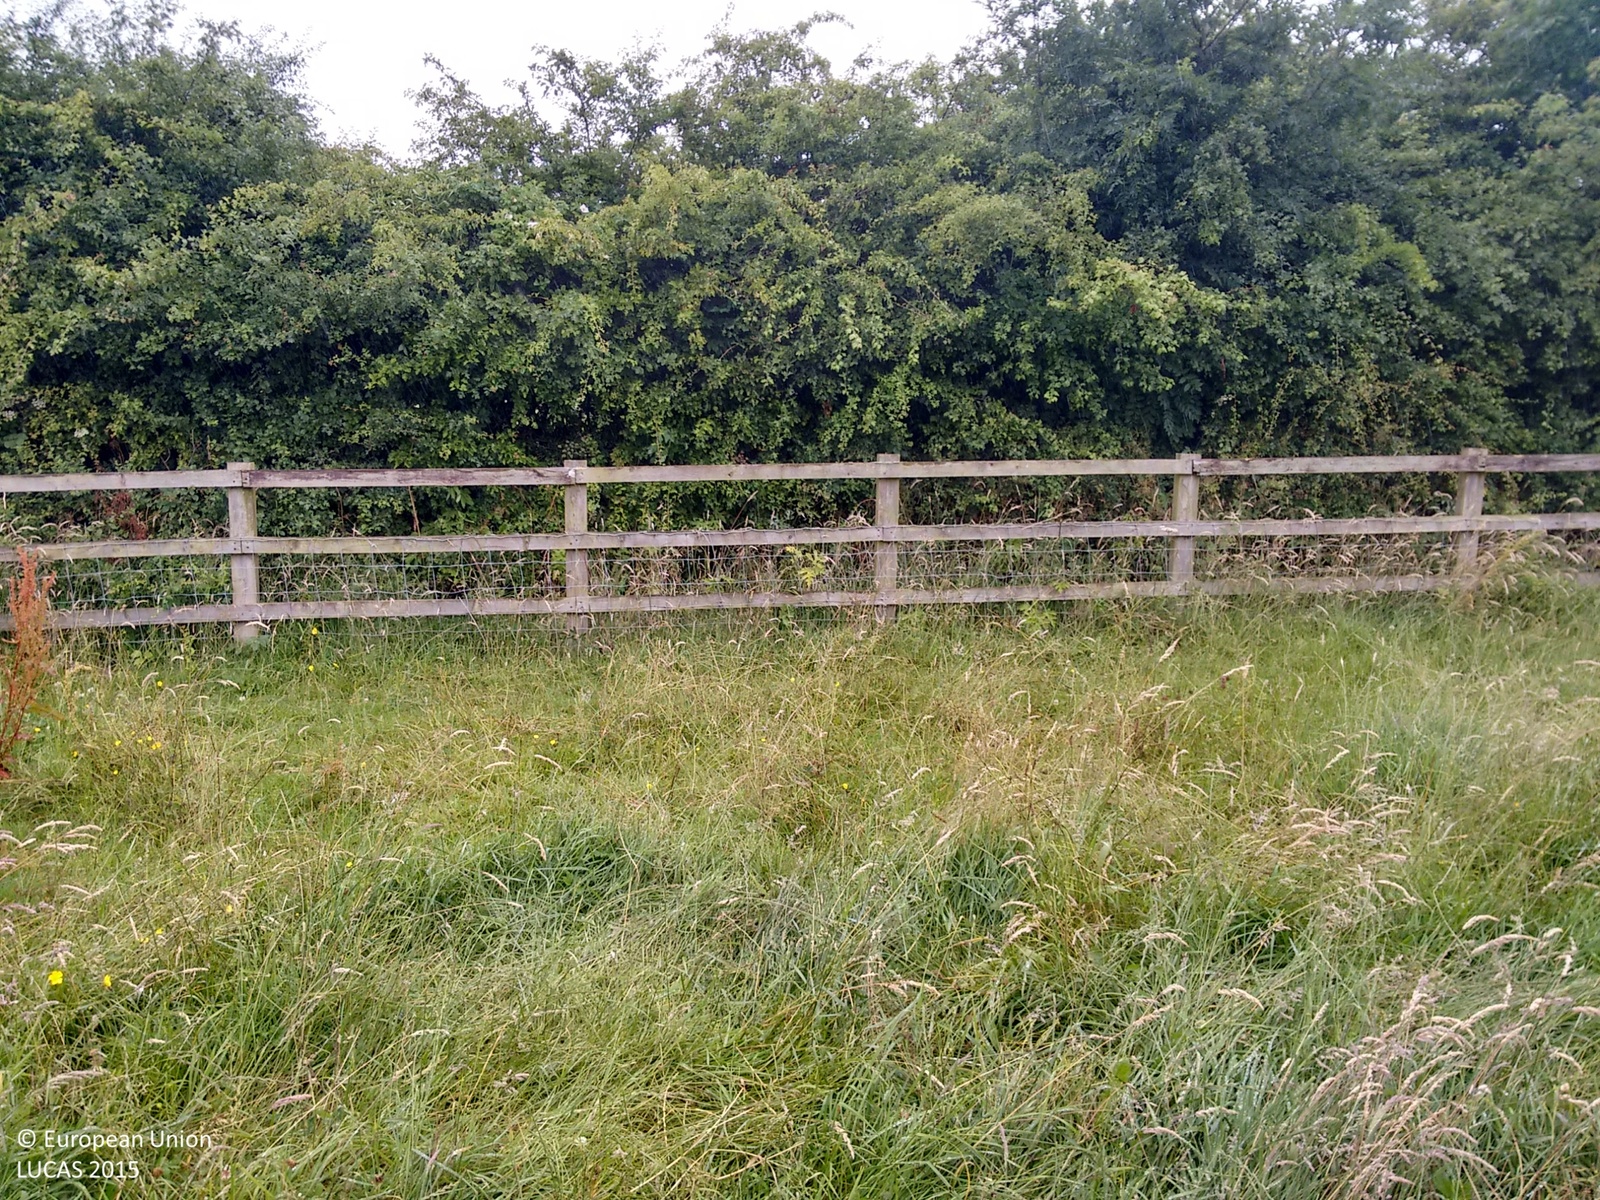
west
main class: Grassland
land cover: Grassland without tree/shrub cover
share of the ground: > 75 %
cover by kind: herbaceous plants 100 %
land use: Agriculture (excluding fallow land and kitchen gardens)
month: July
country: GB
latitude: 53.0665
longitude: -1.3455
